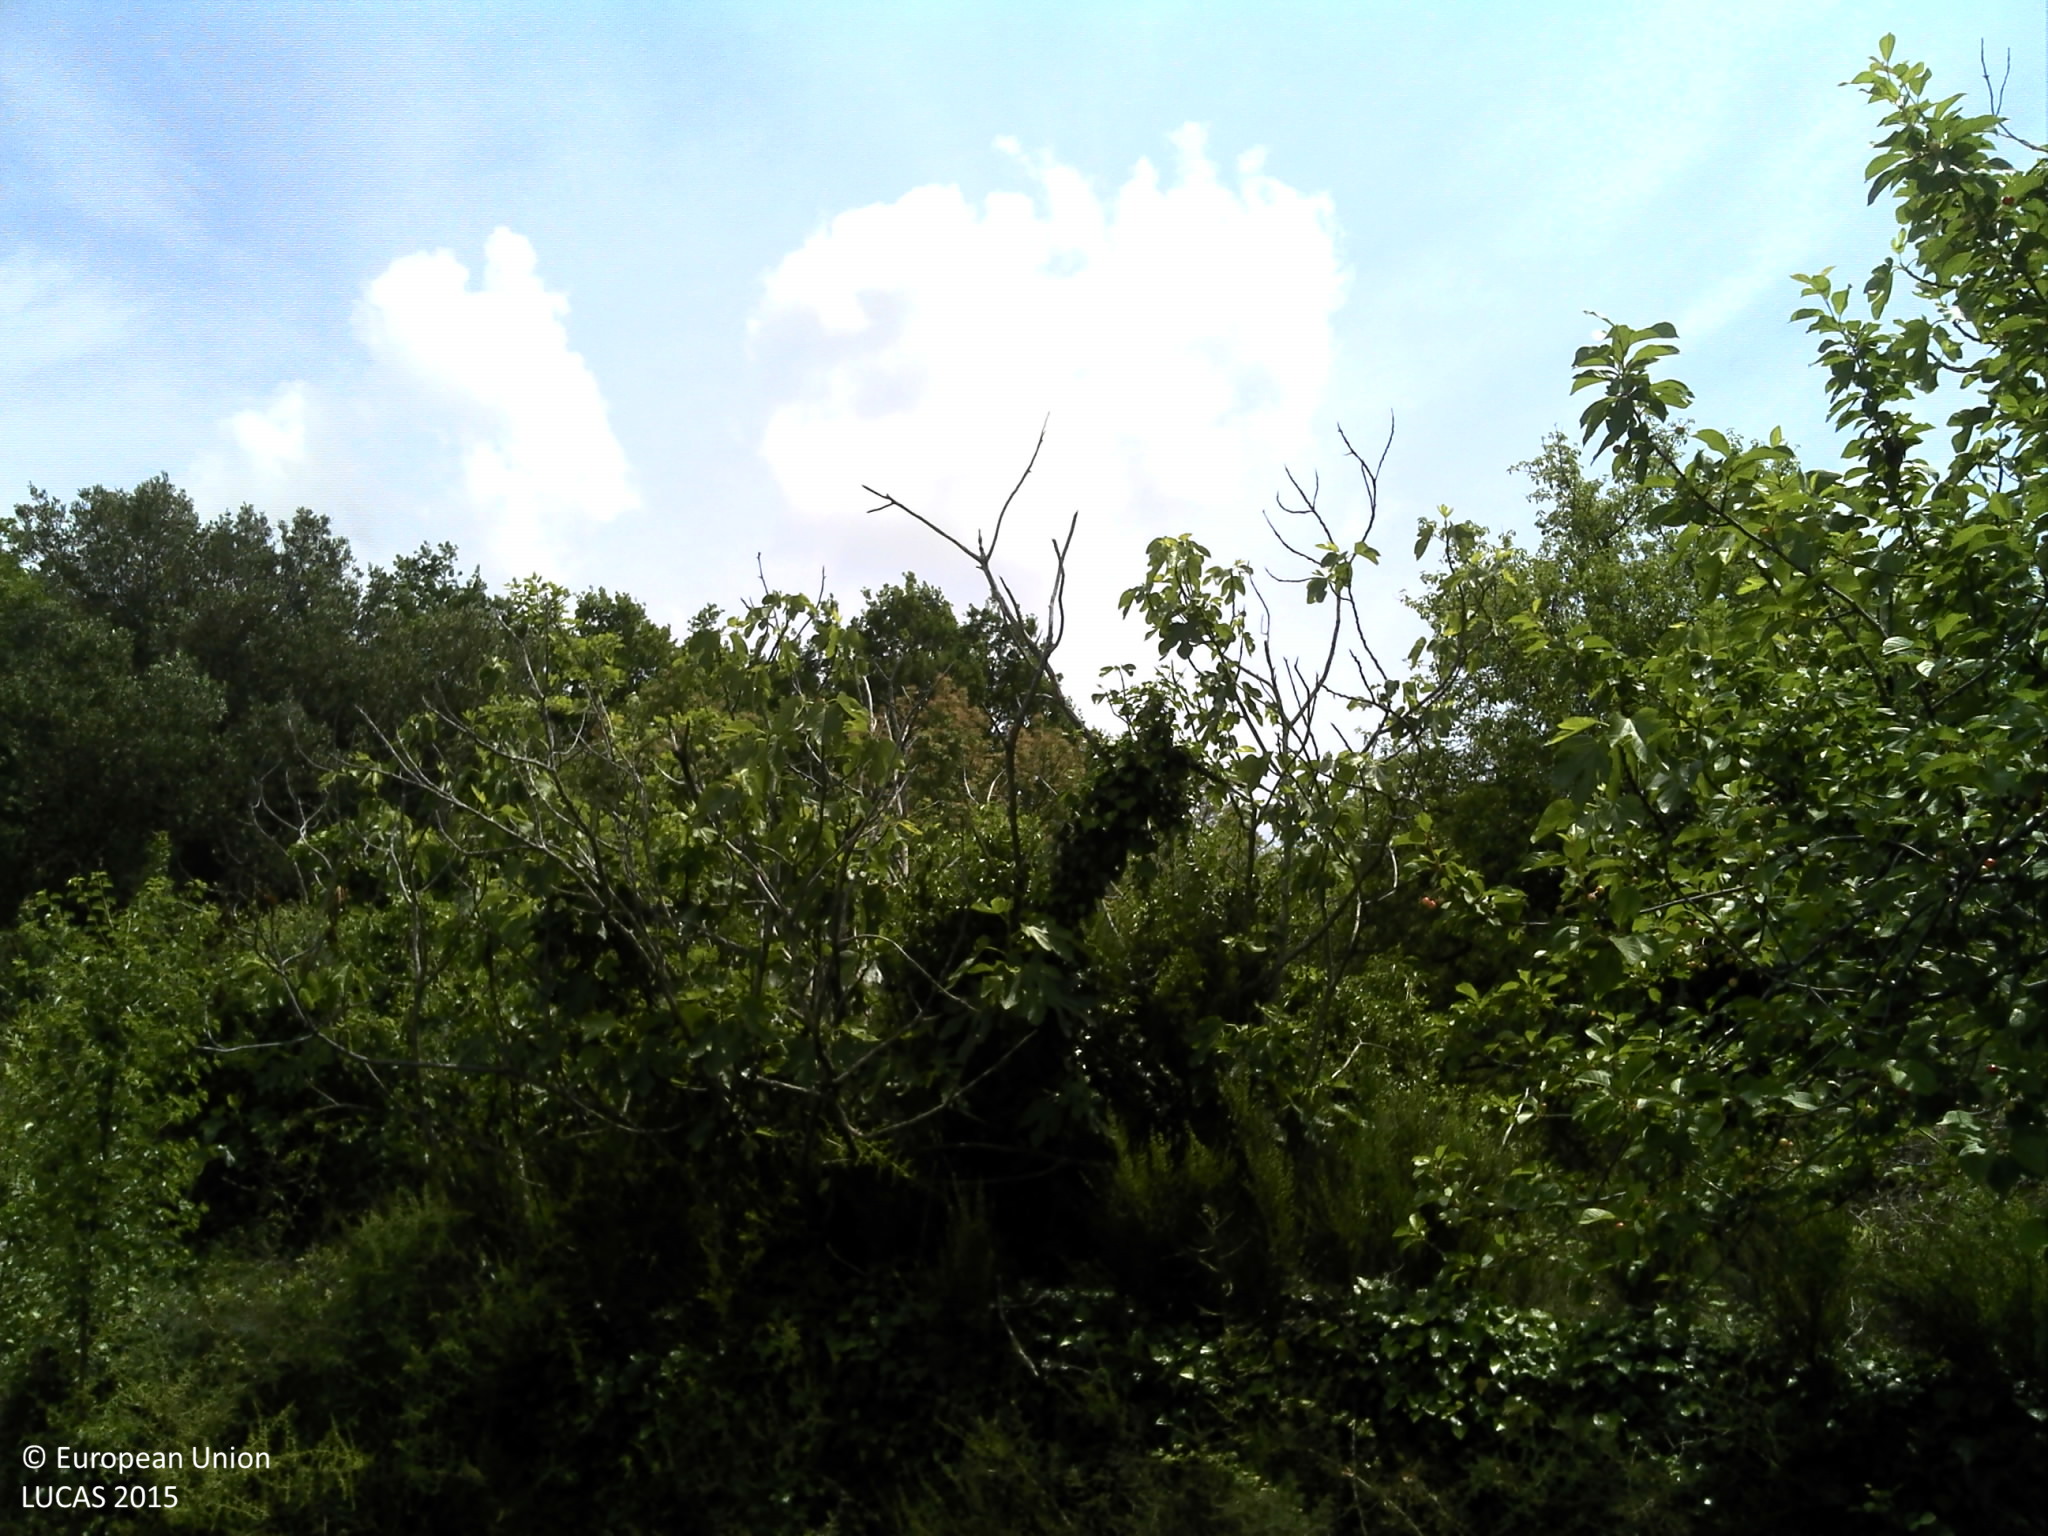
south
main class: Cropland
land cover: Cherry fruit
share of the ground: < 10 %
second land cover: Grassland without tree/shrub cover
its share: > 75 %
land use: Agriculture (excluding fallow land and kitchen gardens)
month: May
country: HR
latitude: 43.5788
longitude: 16.0214
